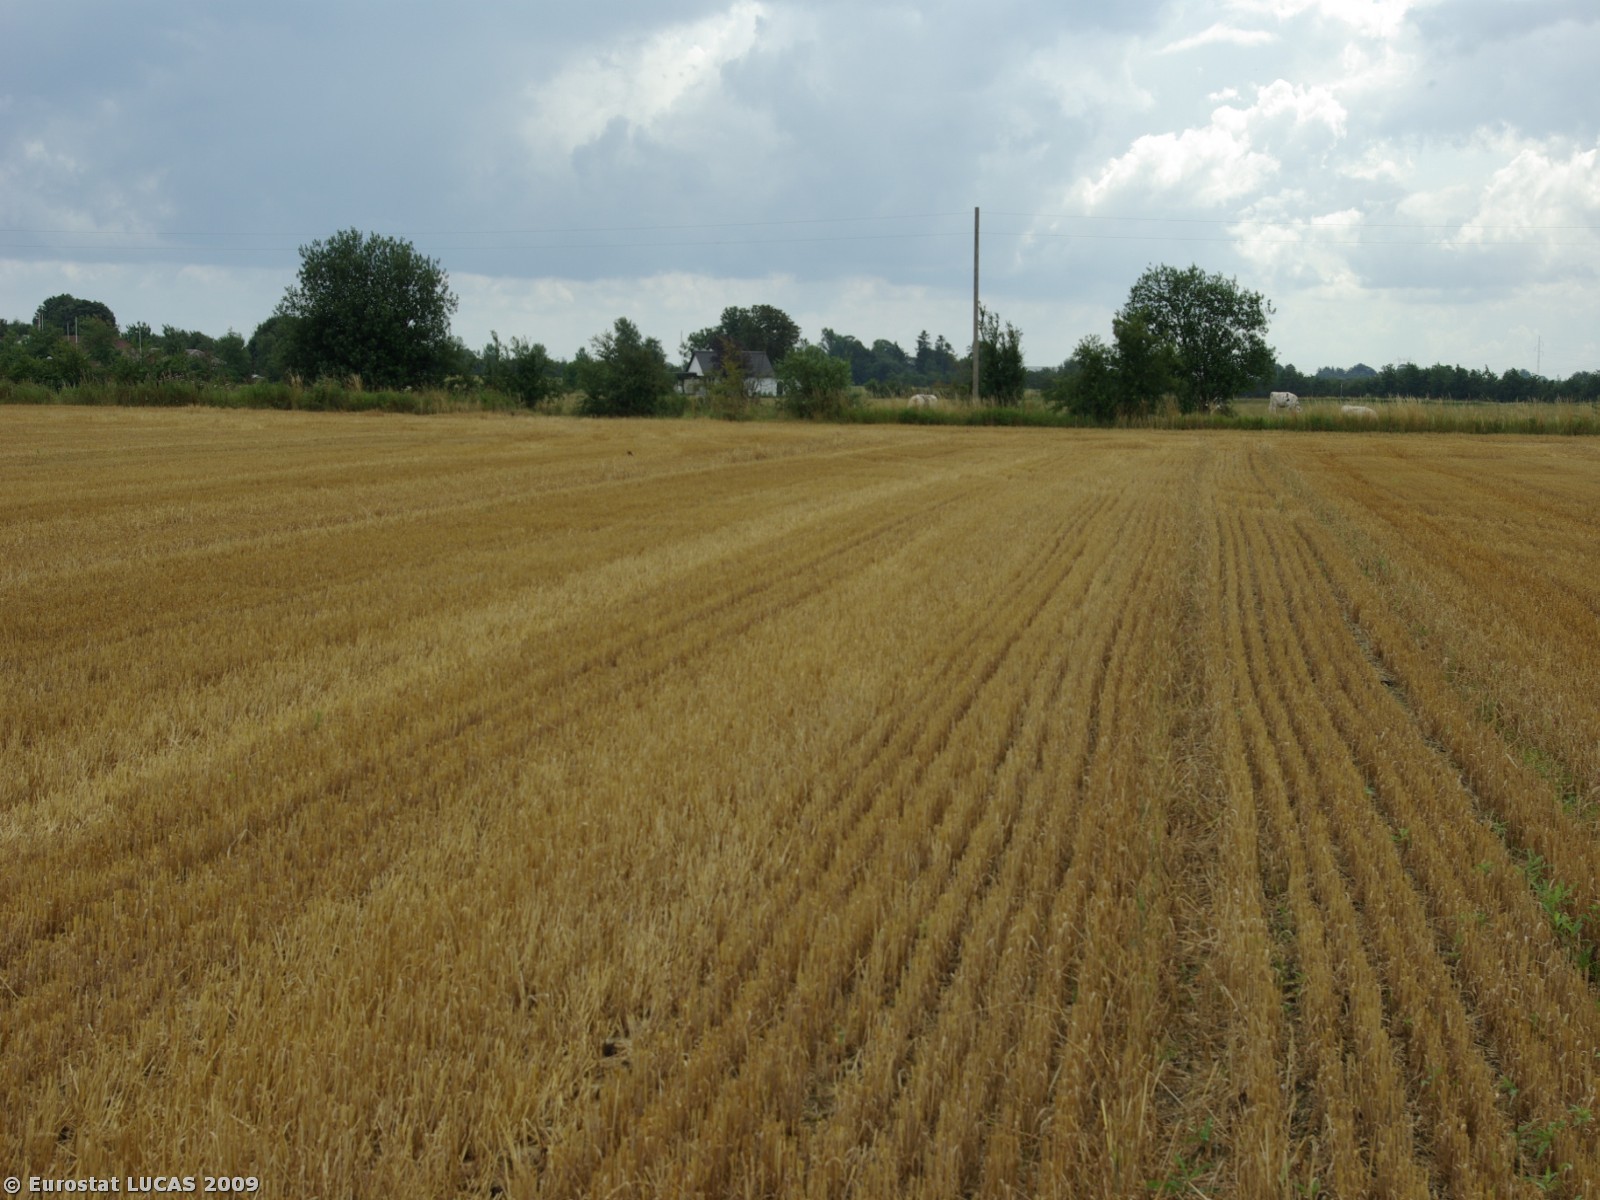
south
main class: Cropland
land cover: Barley
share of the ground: < 10 %
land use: Agriculture (excluding fallow land and kitchen gardens)
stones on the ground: > 50 %
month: July
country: DK
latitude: 55.0354
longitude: 9.2965
